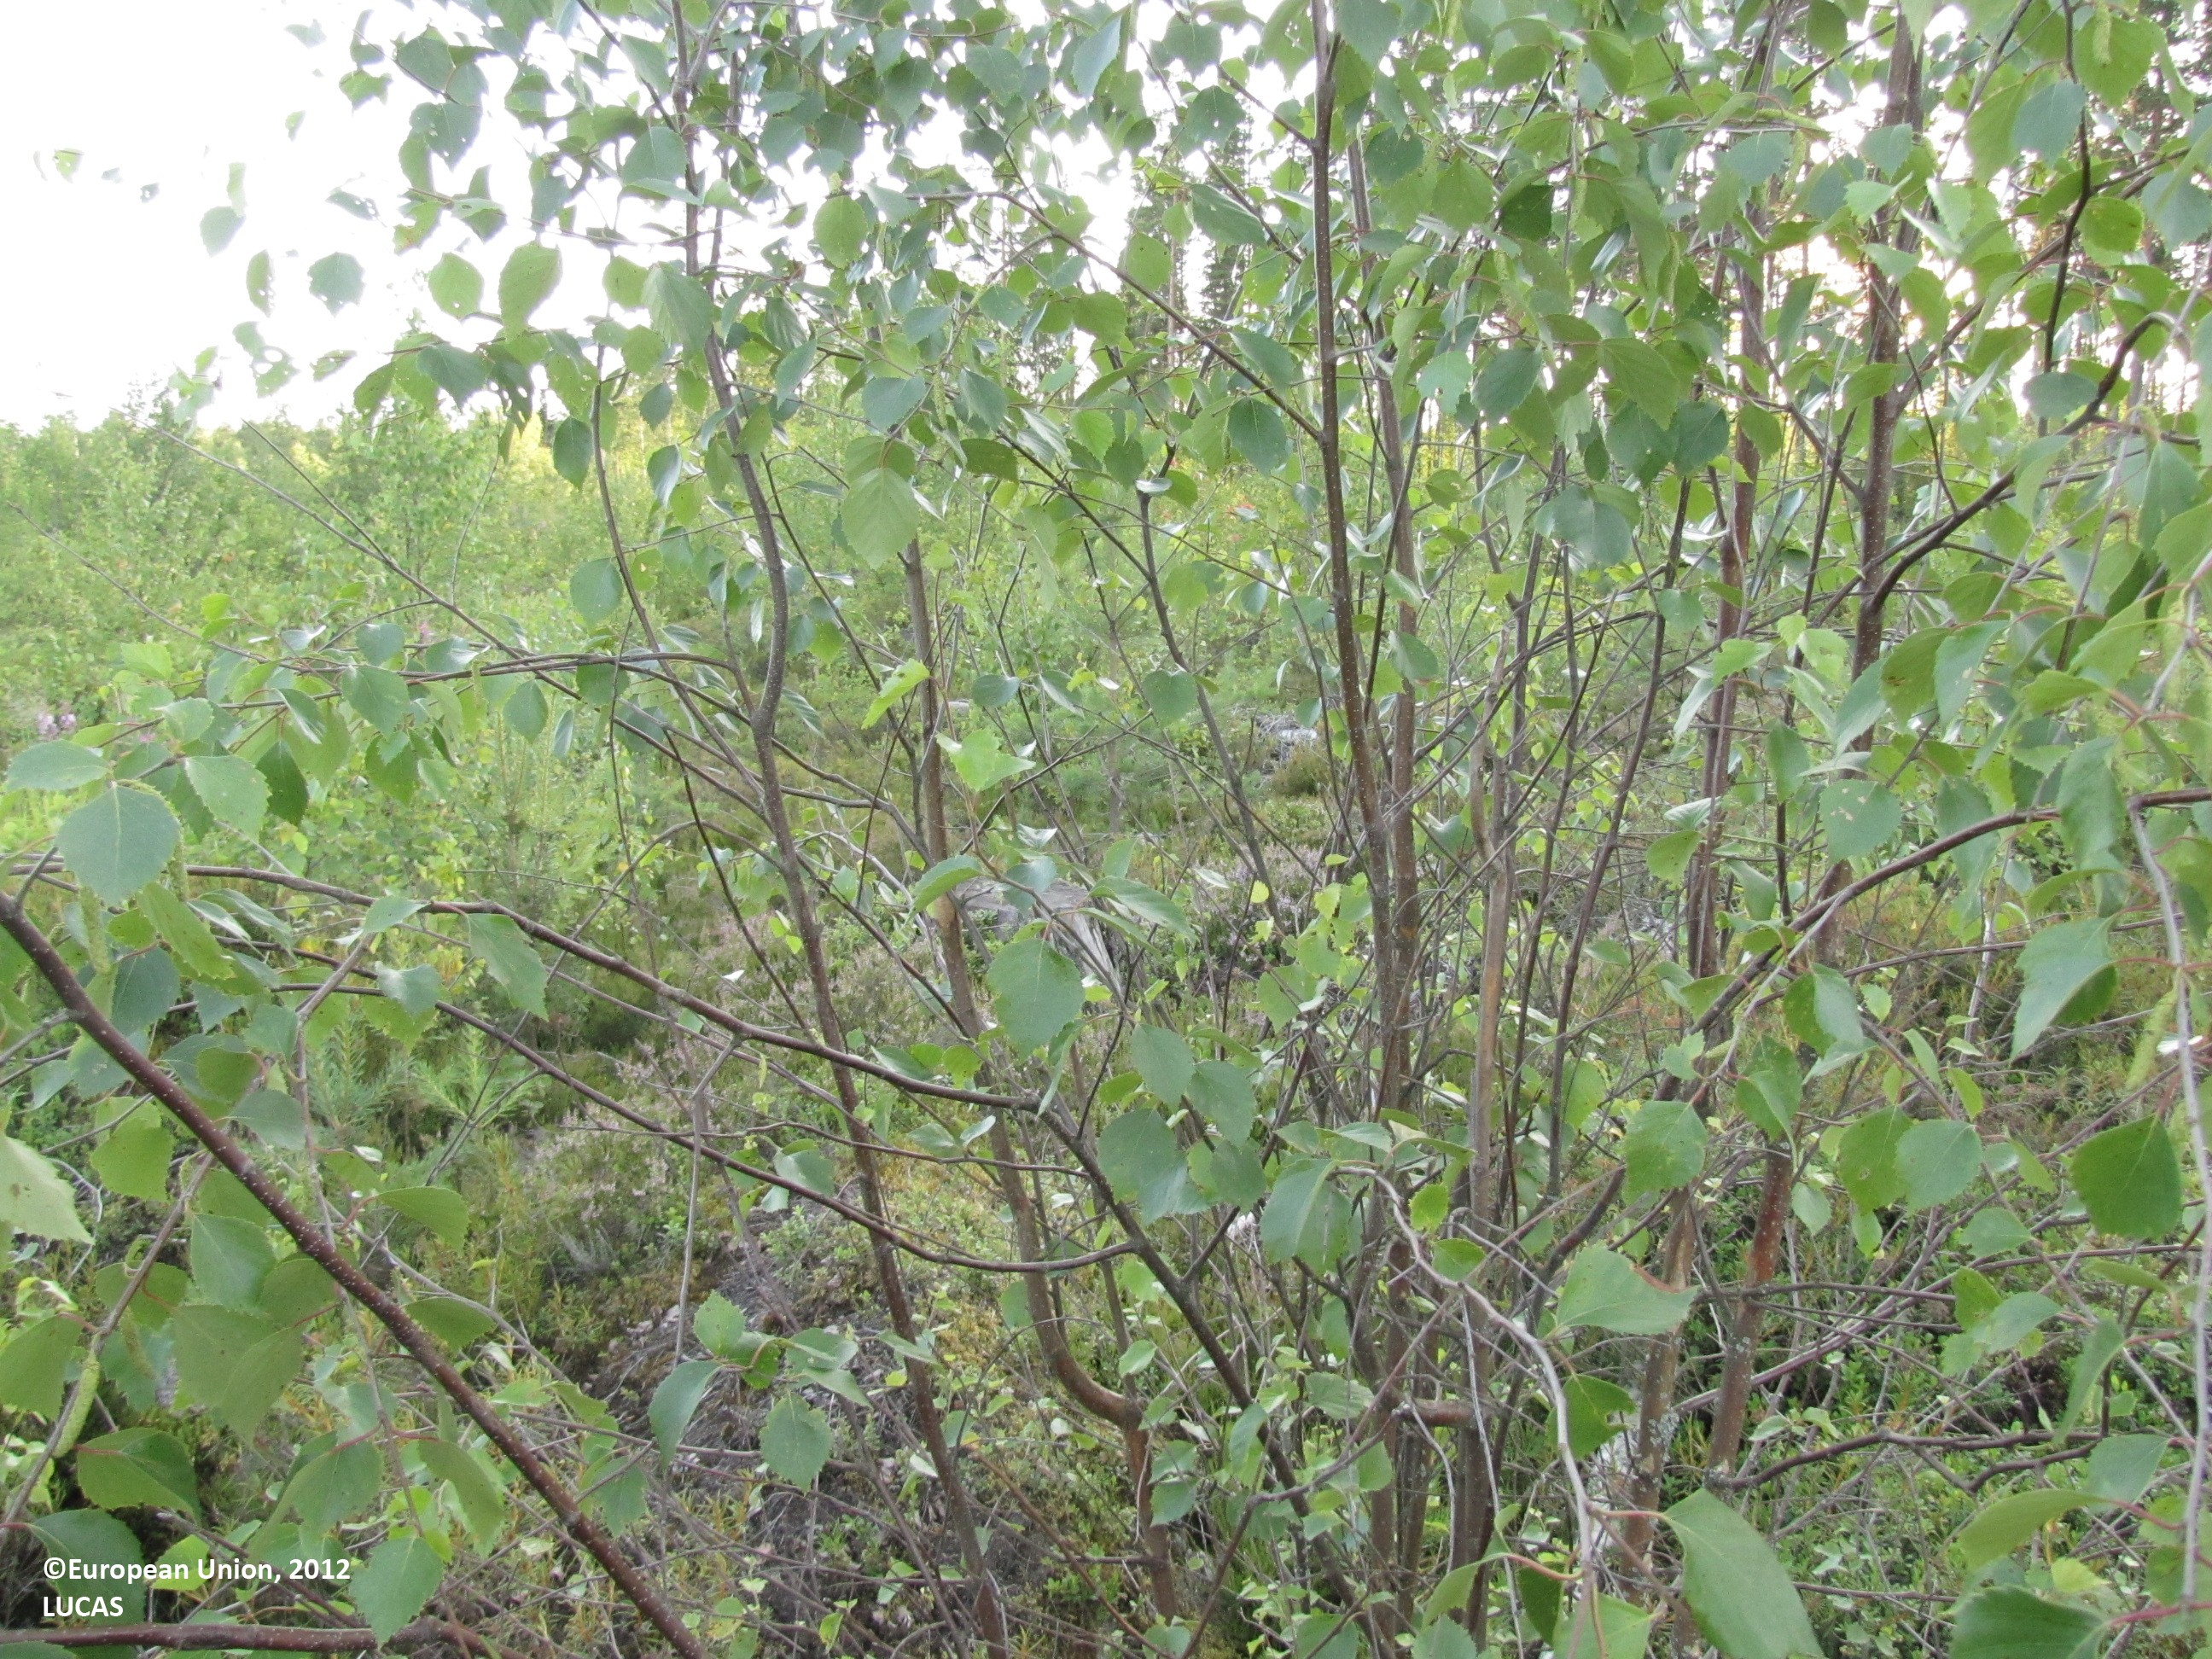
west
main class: Woodland
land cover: Broadleaved woodland
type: mire and swamp forests
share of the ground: 50 - 75 %
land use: Forestry
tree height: < 5 m
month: July
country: FI
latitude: 62.5675
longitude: 23.3174
